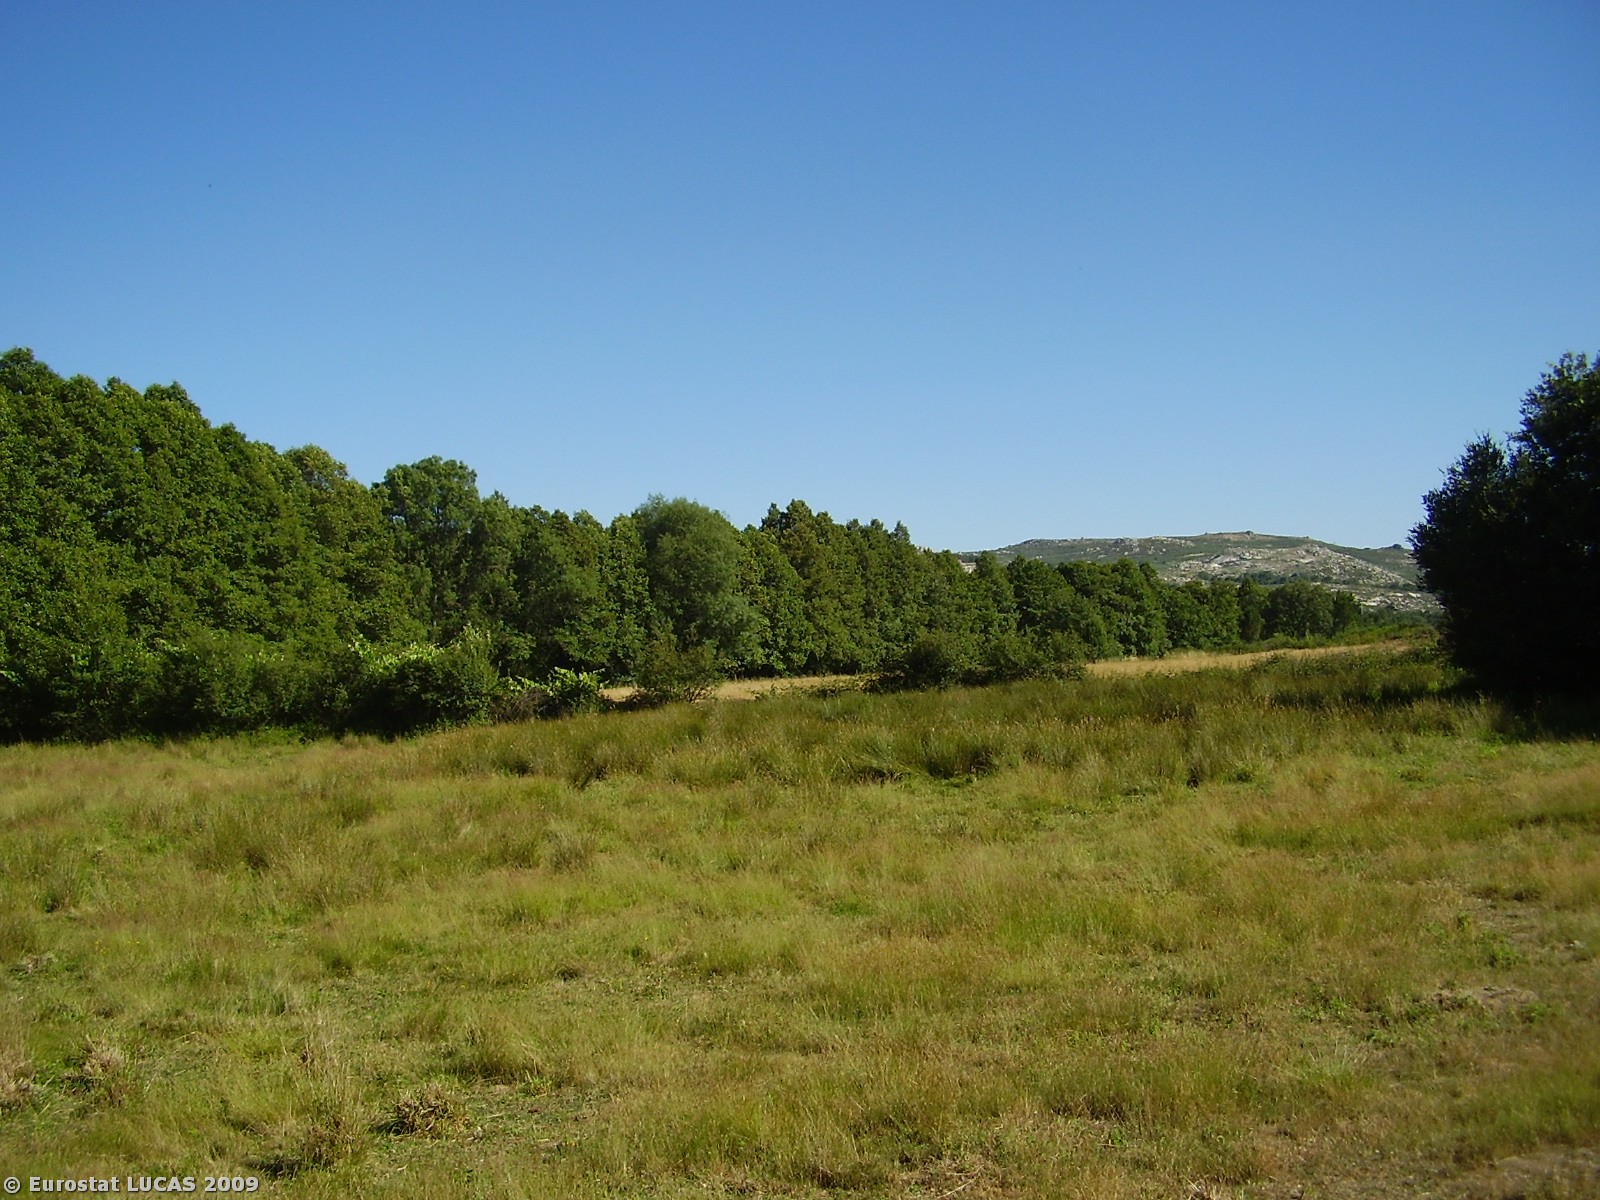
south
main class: Shrubland
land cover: Shrubland with sparse tree cover
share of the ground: > 75 %
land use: Unused
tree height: > 5 m
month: July
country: PT
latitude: 41.4409
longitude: -7.5417
